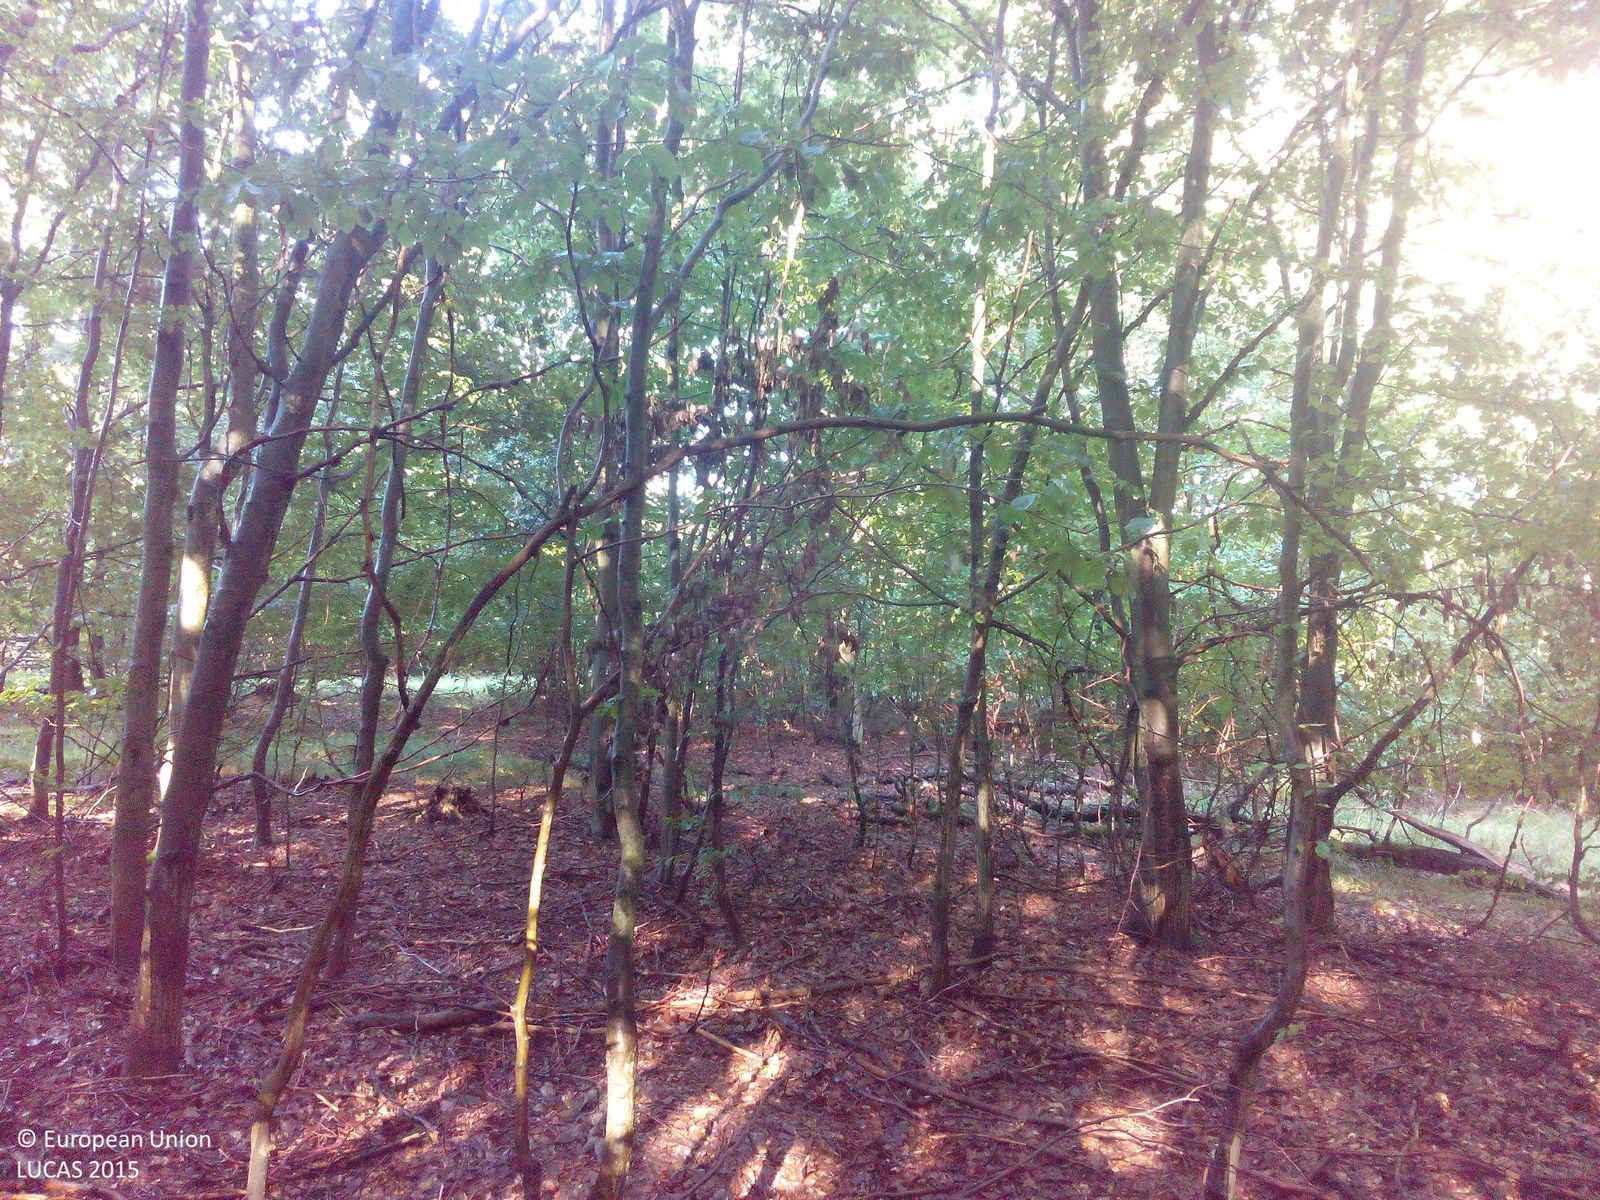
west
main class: Woodland
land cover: Broadleaved woodland
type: beech forest
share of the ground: > 75 %
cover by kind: broadleaved forest trees 100 %
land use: Forestry
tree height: > 5 m
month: August
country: DE
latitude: 51.7086
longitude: 10.9404
